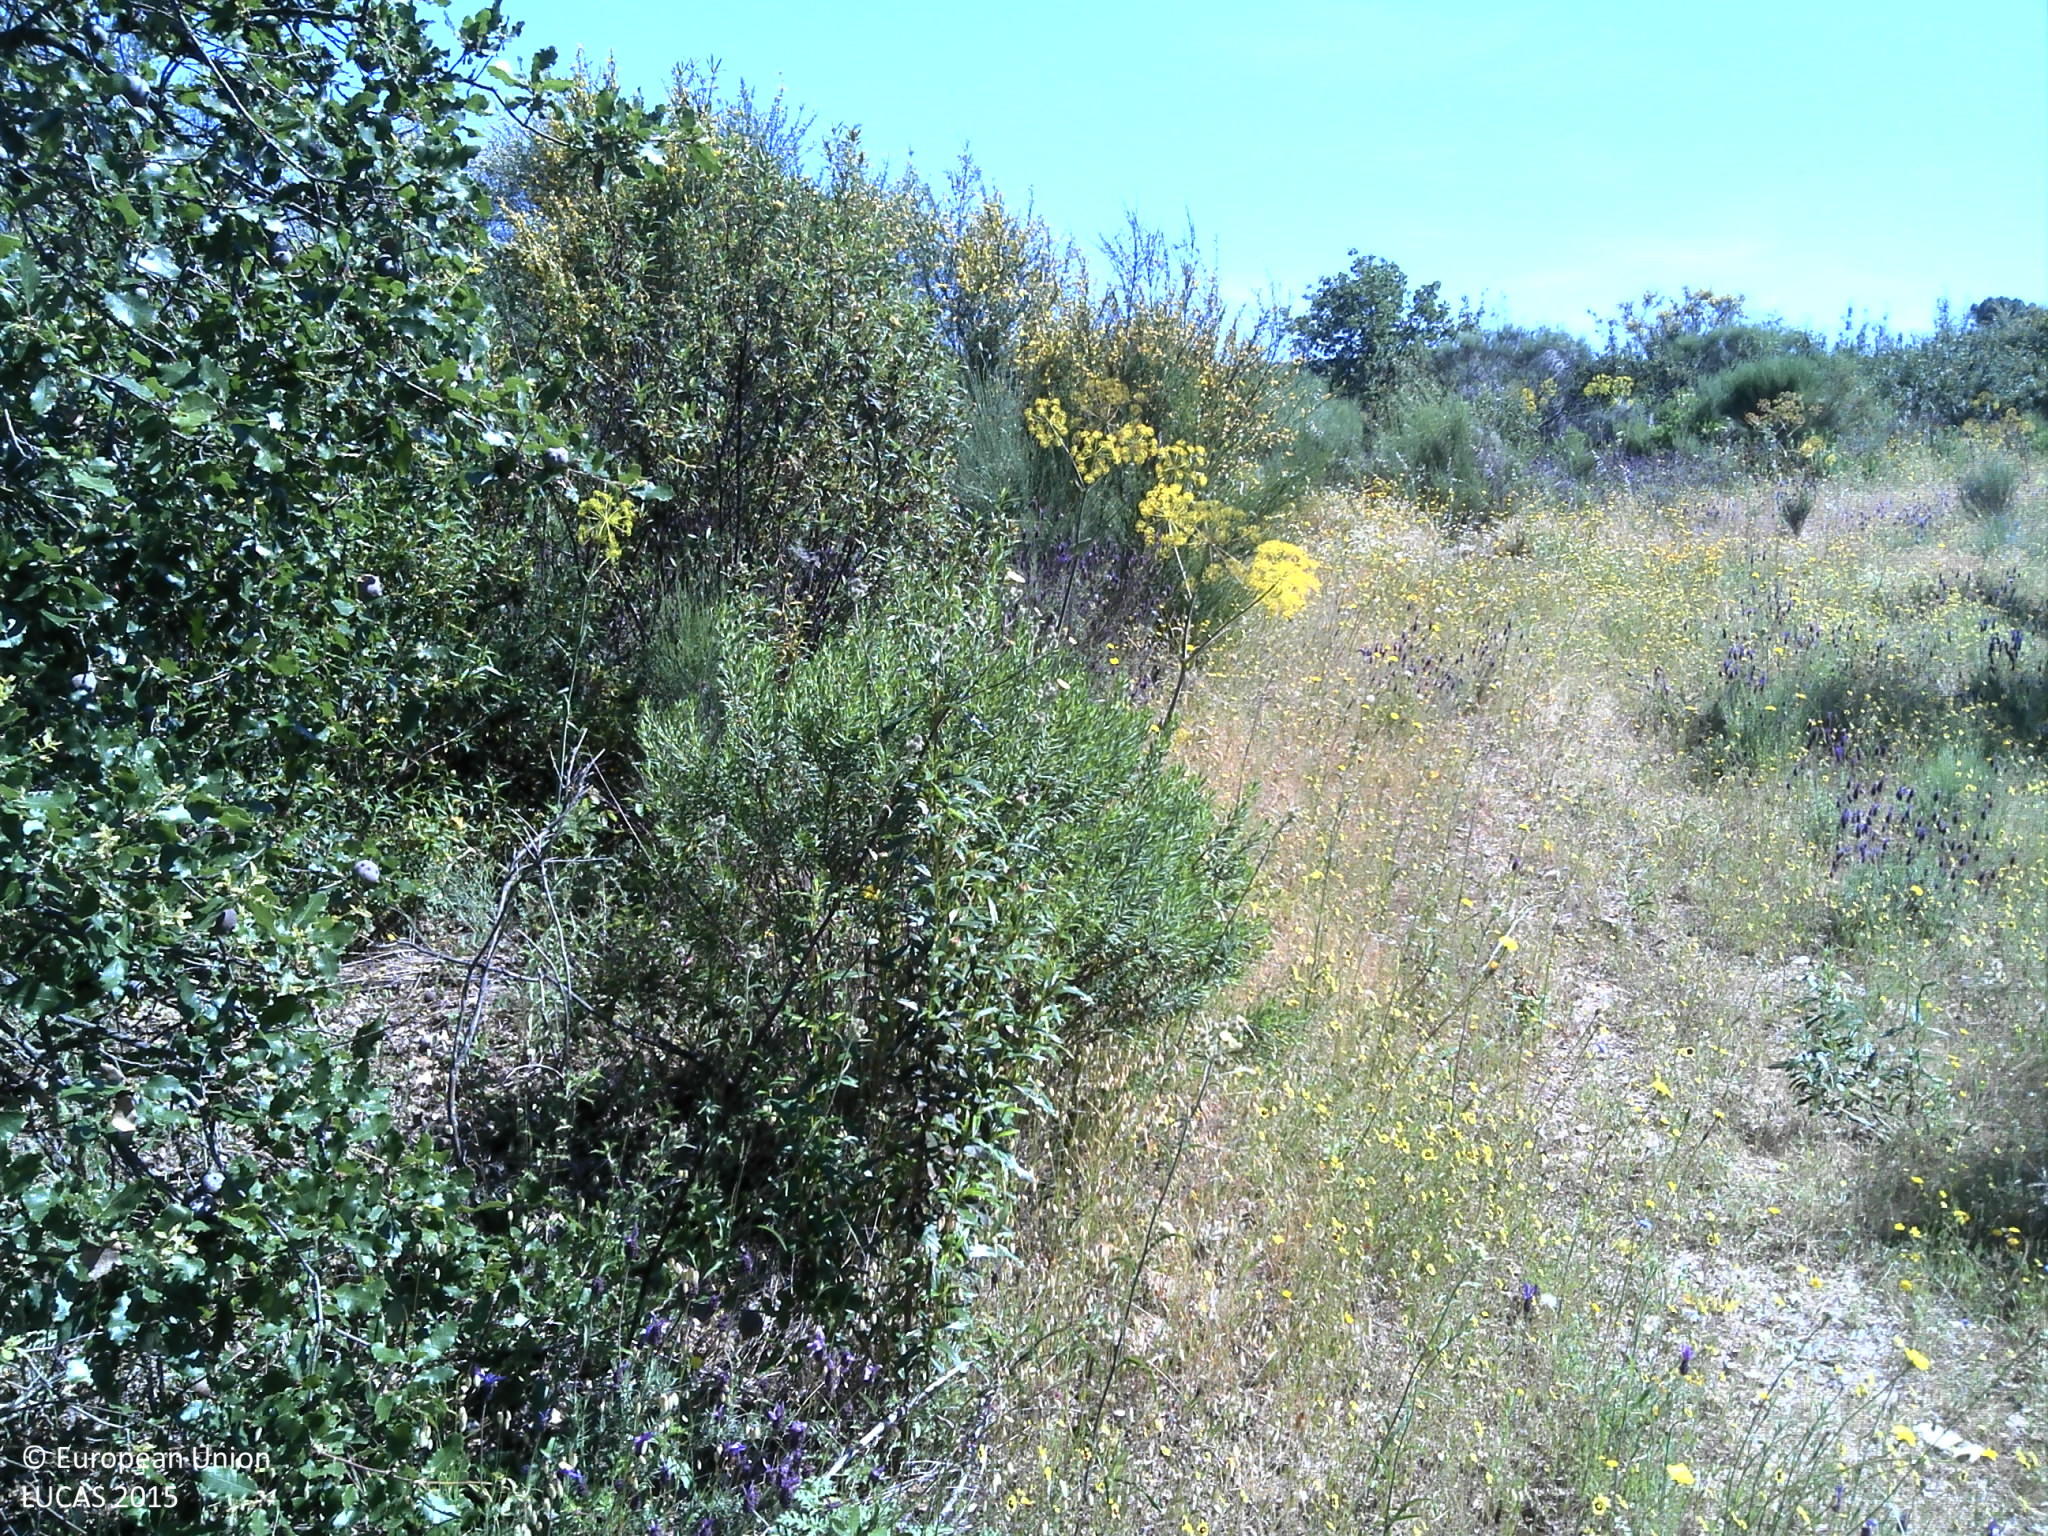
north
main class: Shrubland
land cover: Shrubland with sparse tree cover
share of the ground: > 75 %
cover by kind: shrubs 95 %, broadleaved forest trees 5 %
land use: Abandoned areas
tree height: > 5 m
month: May
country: PT
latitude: 41.1218
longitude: -6.8391
